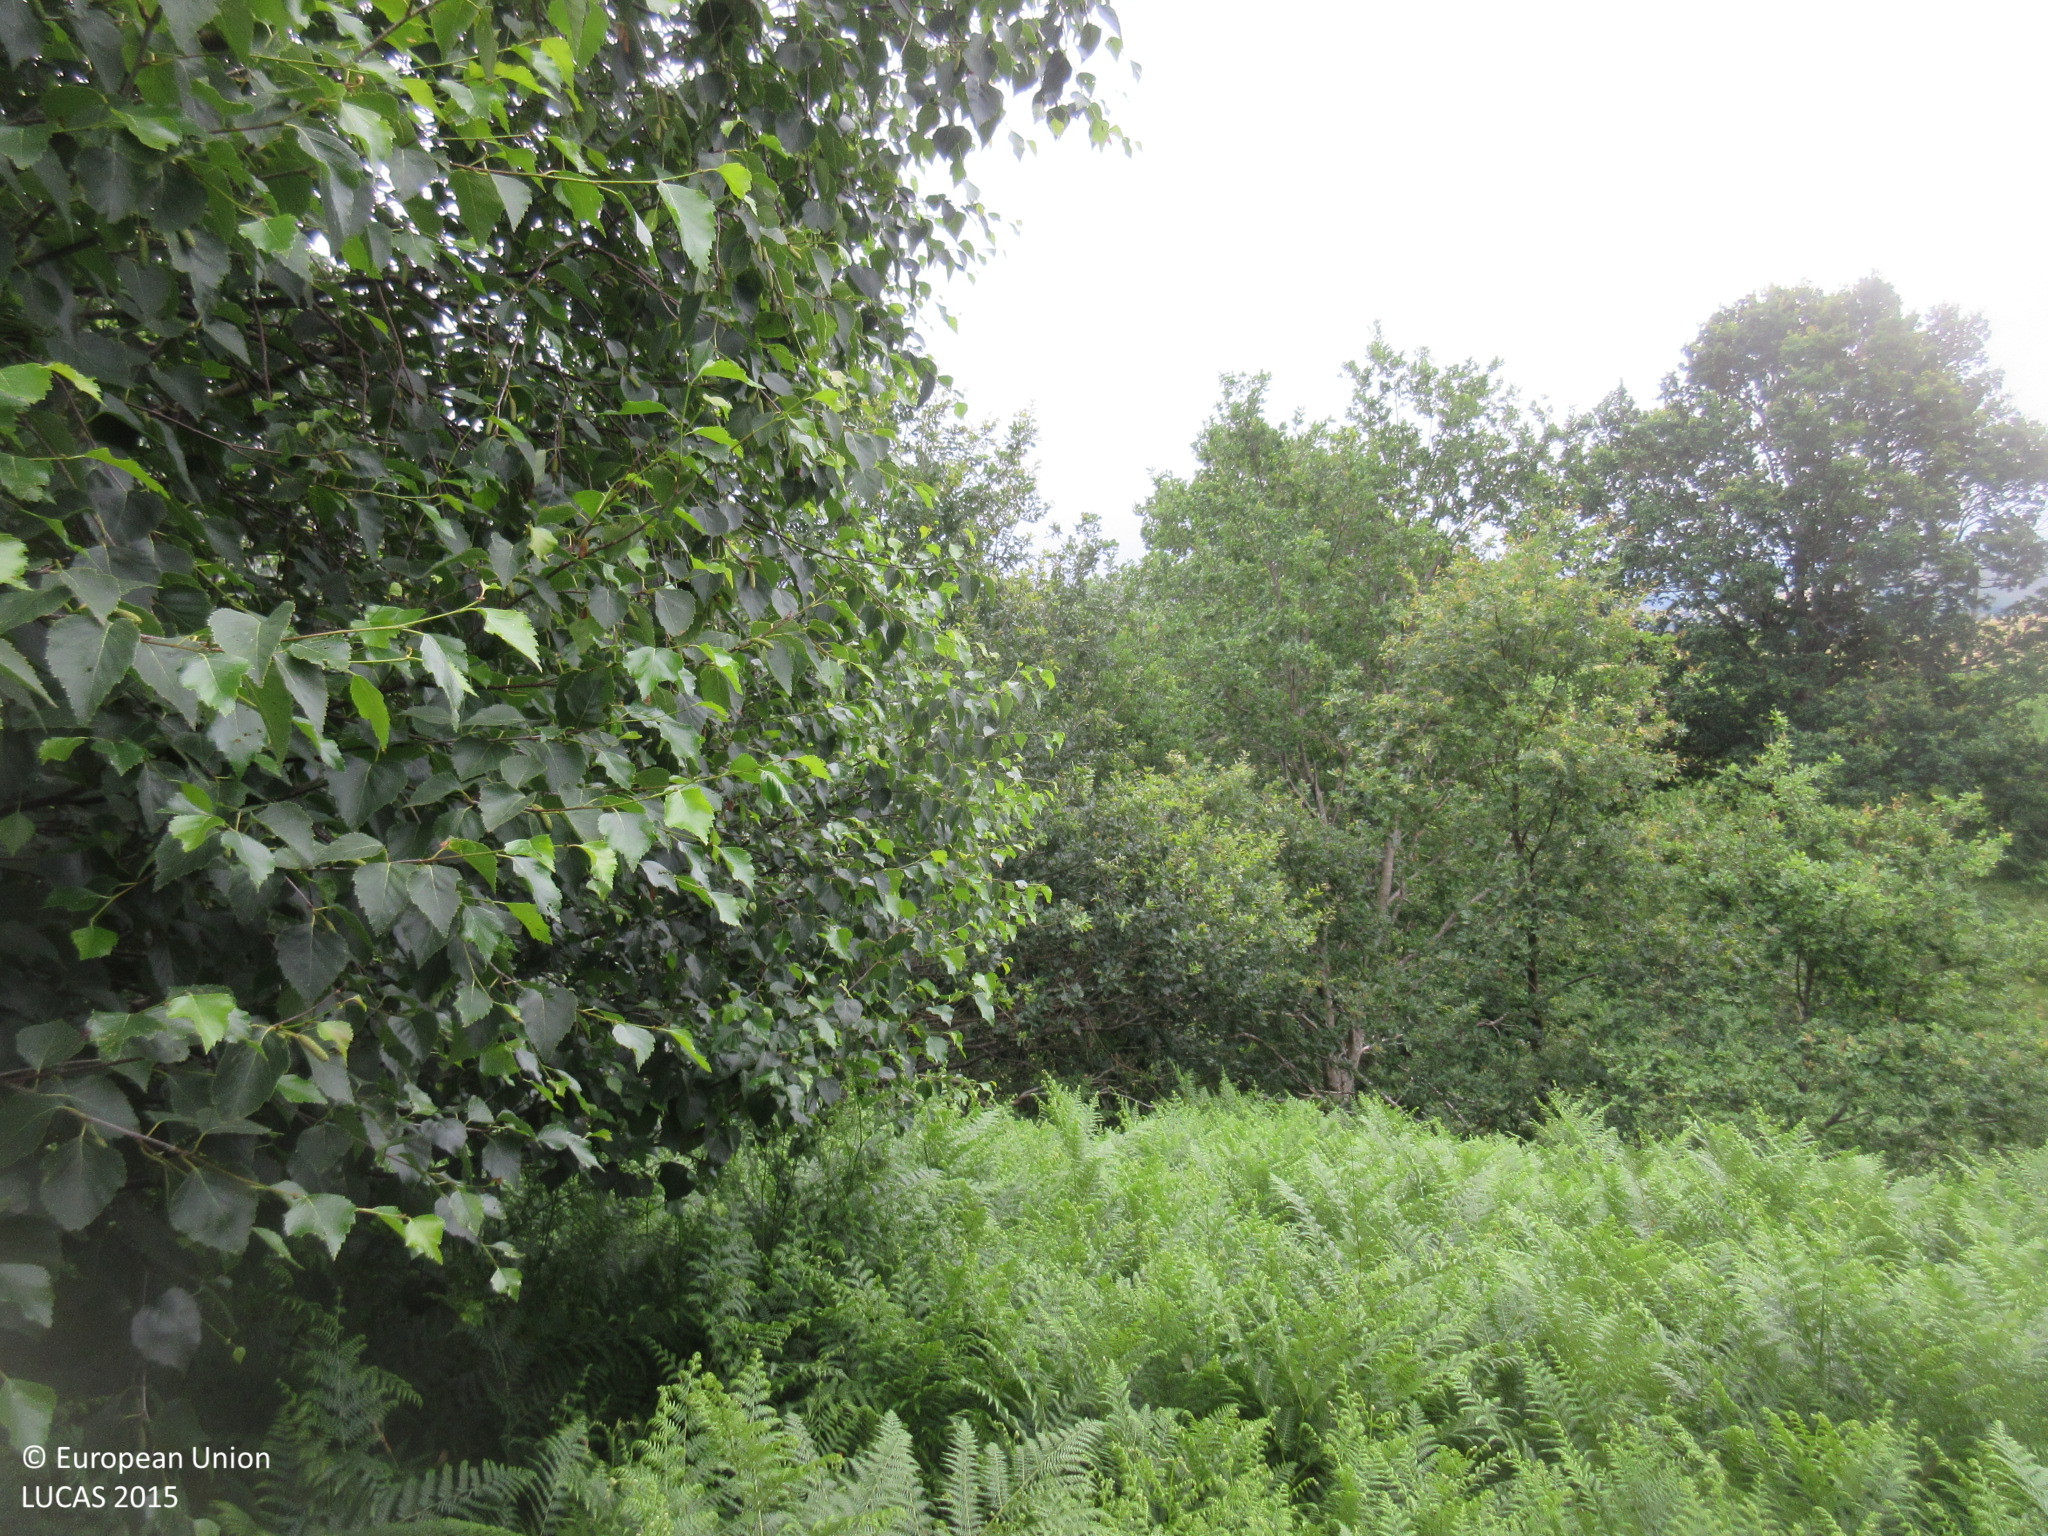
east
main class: Woodland
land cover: Broadleaved woodland
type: acidophilous oak and oak-birch forest
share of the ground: 25 - 50 %
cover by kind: herbaceous plants 60 %, broadleaved forest trees 40 %
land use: Semi-natural and natural areas not in use
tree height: > 5 m
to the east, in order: Broadleaved woodland; Fences; Tracks; Grassland with sparse tree/shrub cover
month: July
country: ES
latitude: 43.2263
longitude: -3.4991
